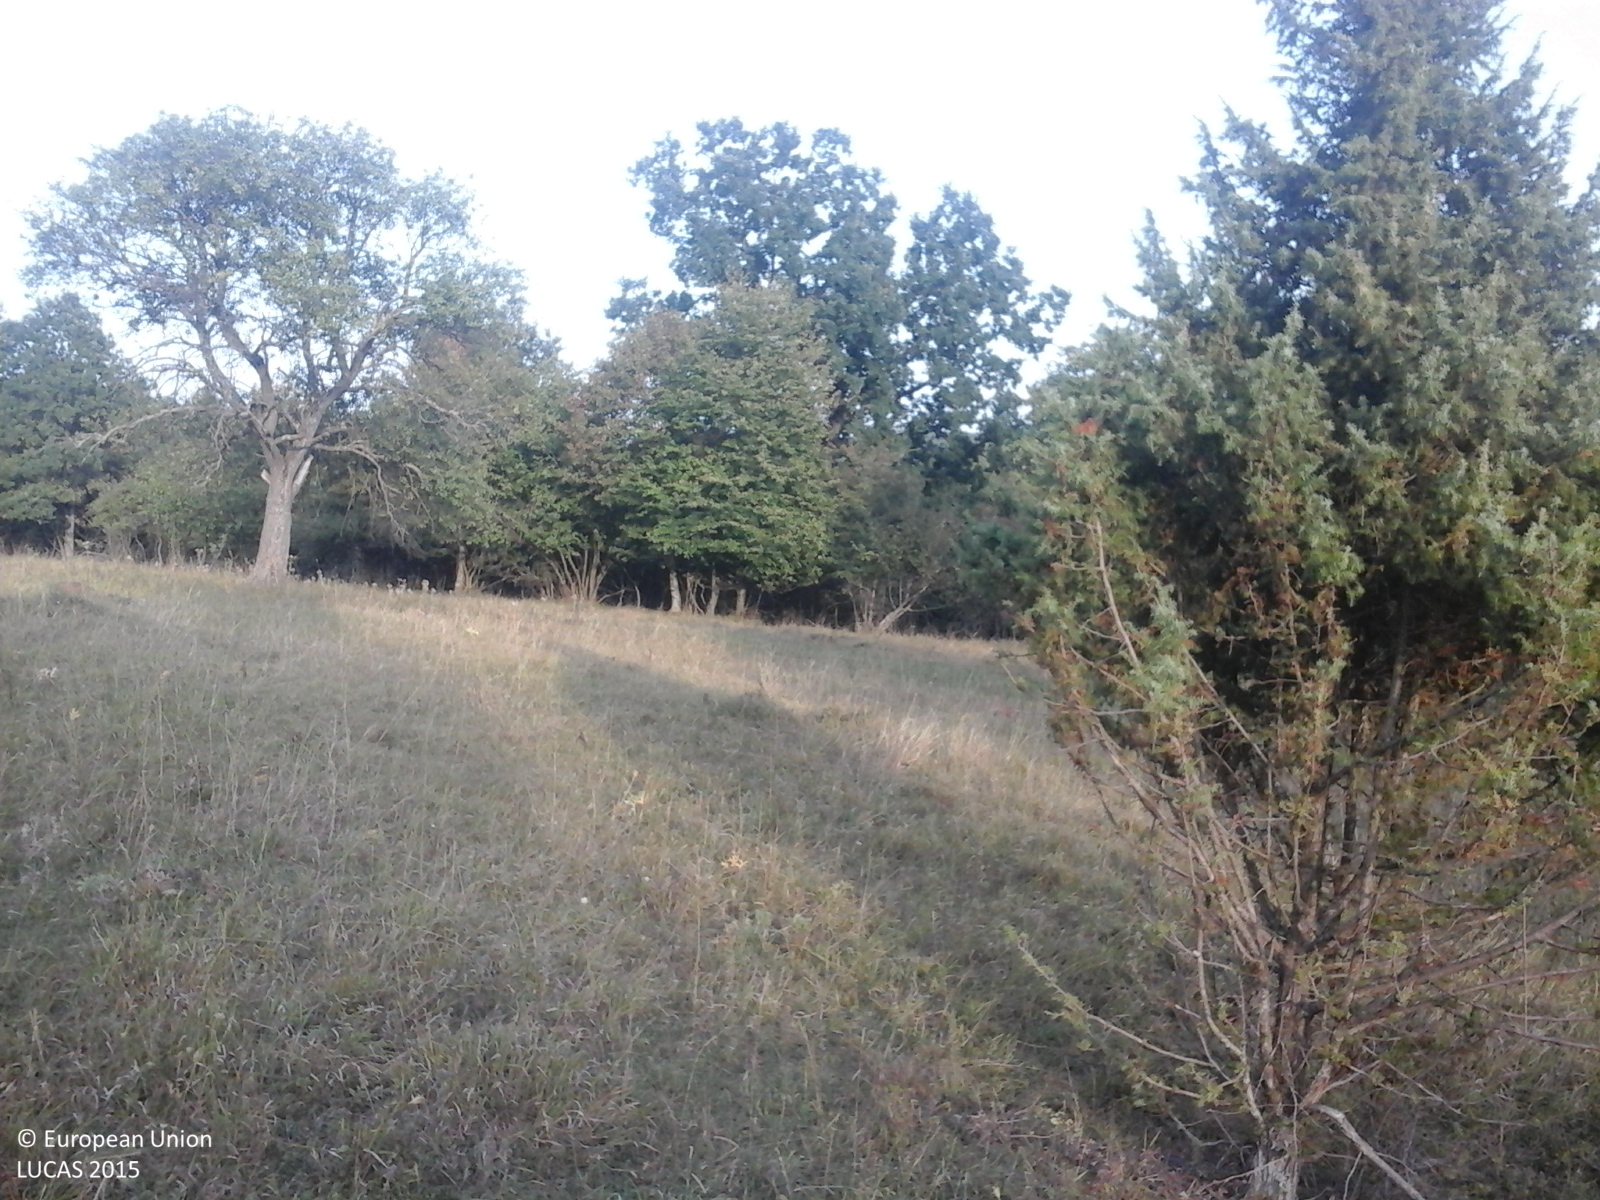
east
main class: Grassland
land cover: Grassland with sparse tree/shrub cover
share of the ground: > 75 %
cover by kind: herbaceous plants 85 %, shrubs 10 %, broadleaved forest trees 5 %
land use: Fallow land
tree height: < 5 m
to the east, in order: Grassland with sparse tree/shrub cover; Tracks; Broadleaved woodland
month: September
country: RO
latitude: 46.8206
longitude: 23.0781
